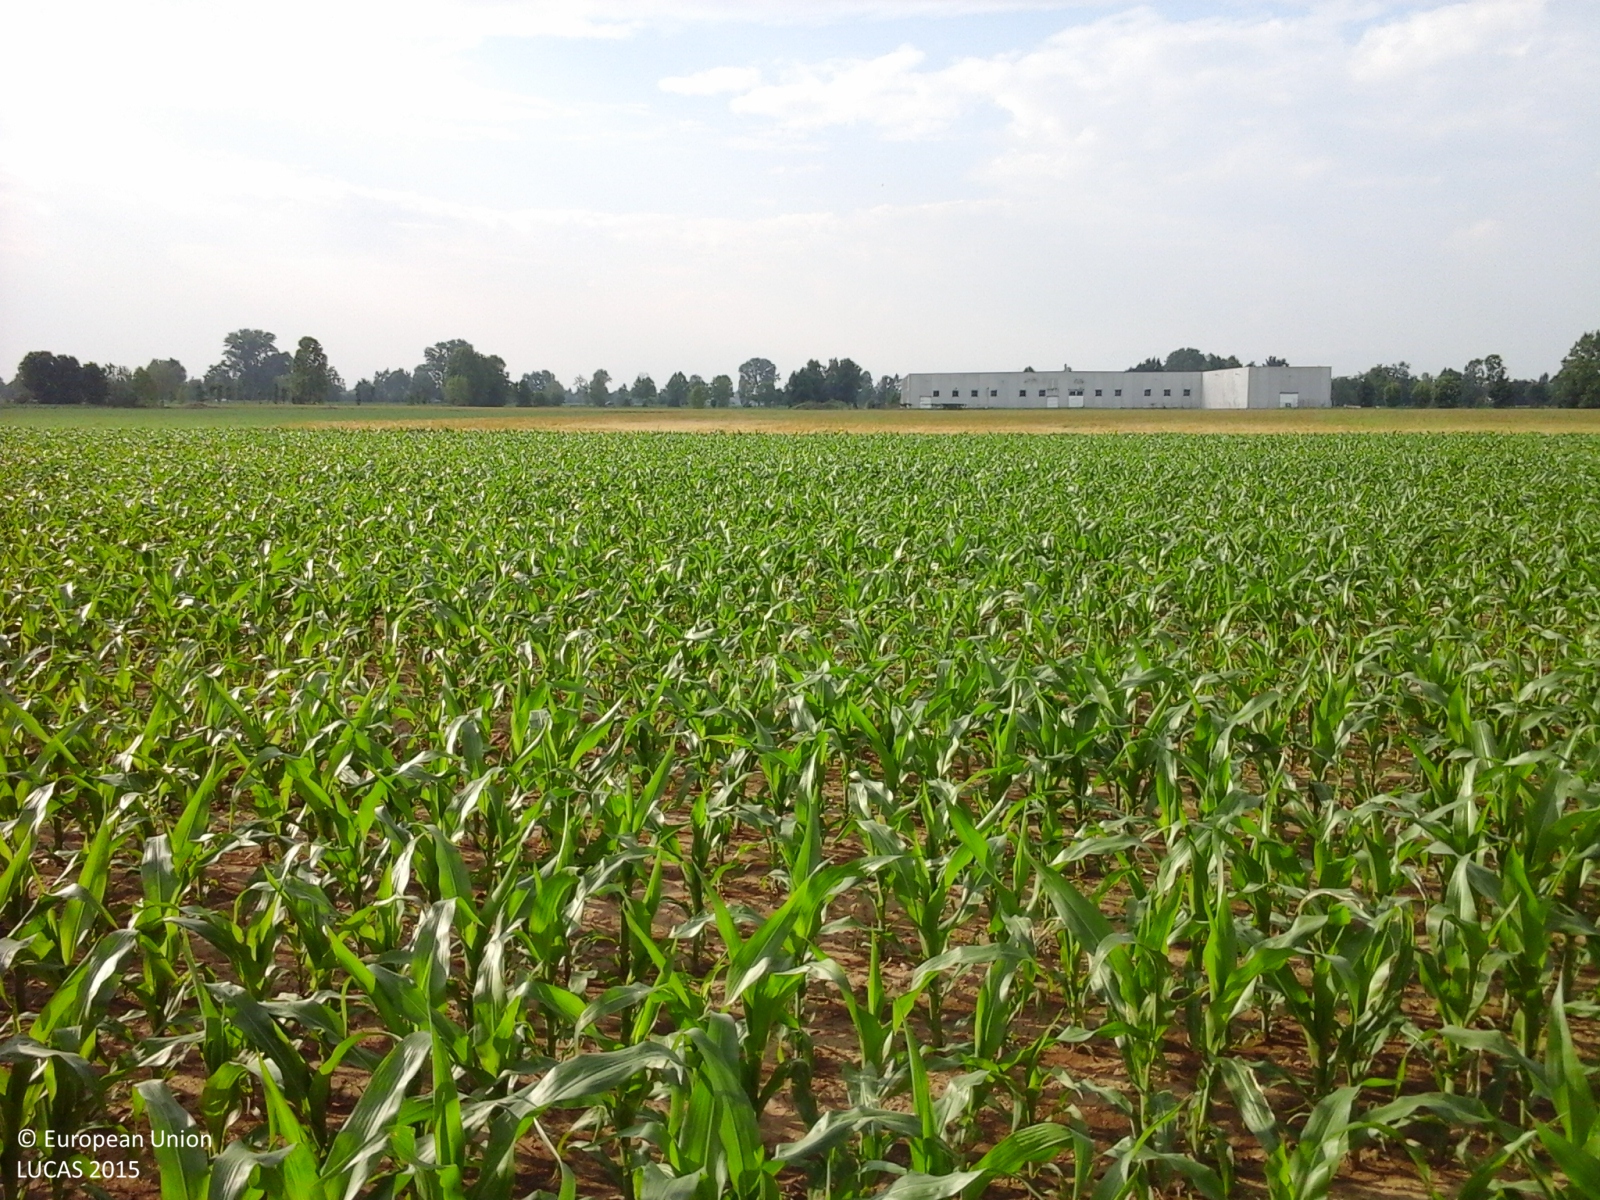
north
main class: Cropland
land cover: Maize
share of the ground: 25 - 50 %
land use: Agriculture (excluding fallow land and kitchen gardens)
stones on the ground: < 10 %
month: May
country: IT
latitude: 45.5219
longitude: 9.6549
